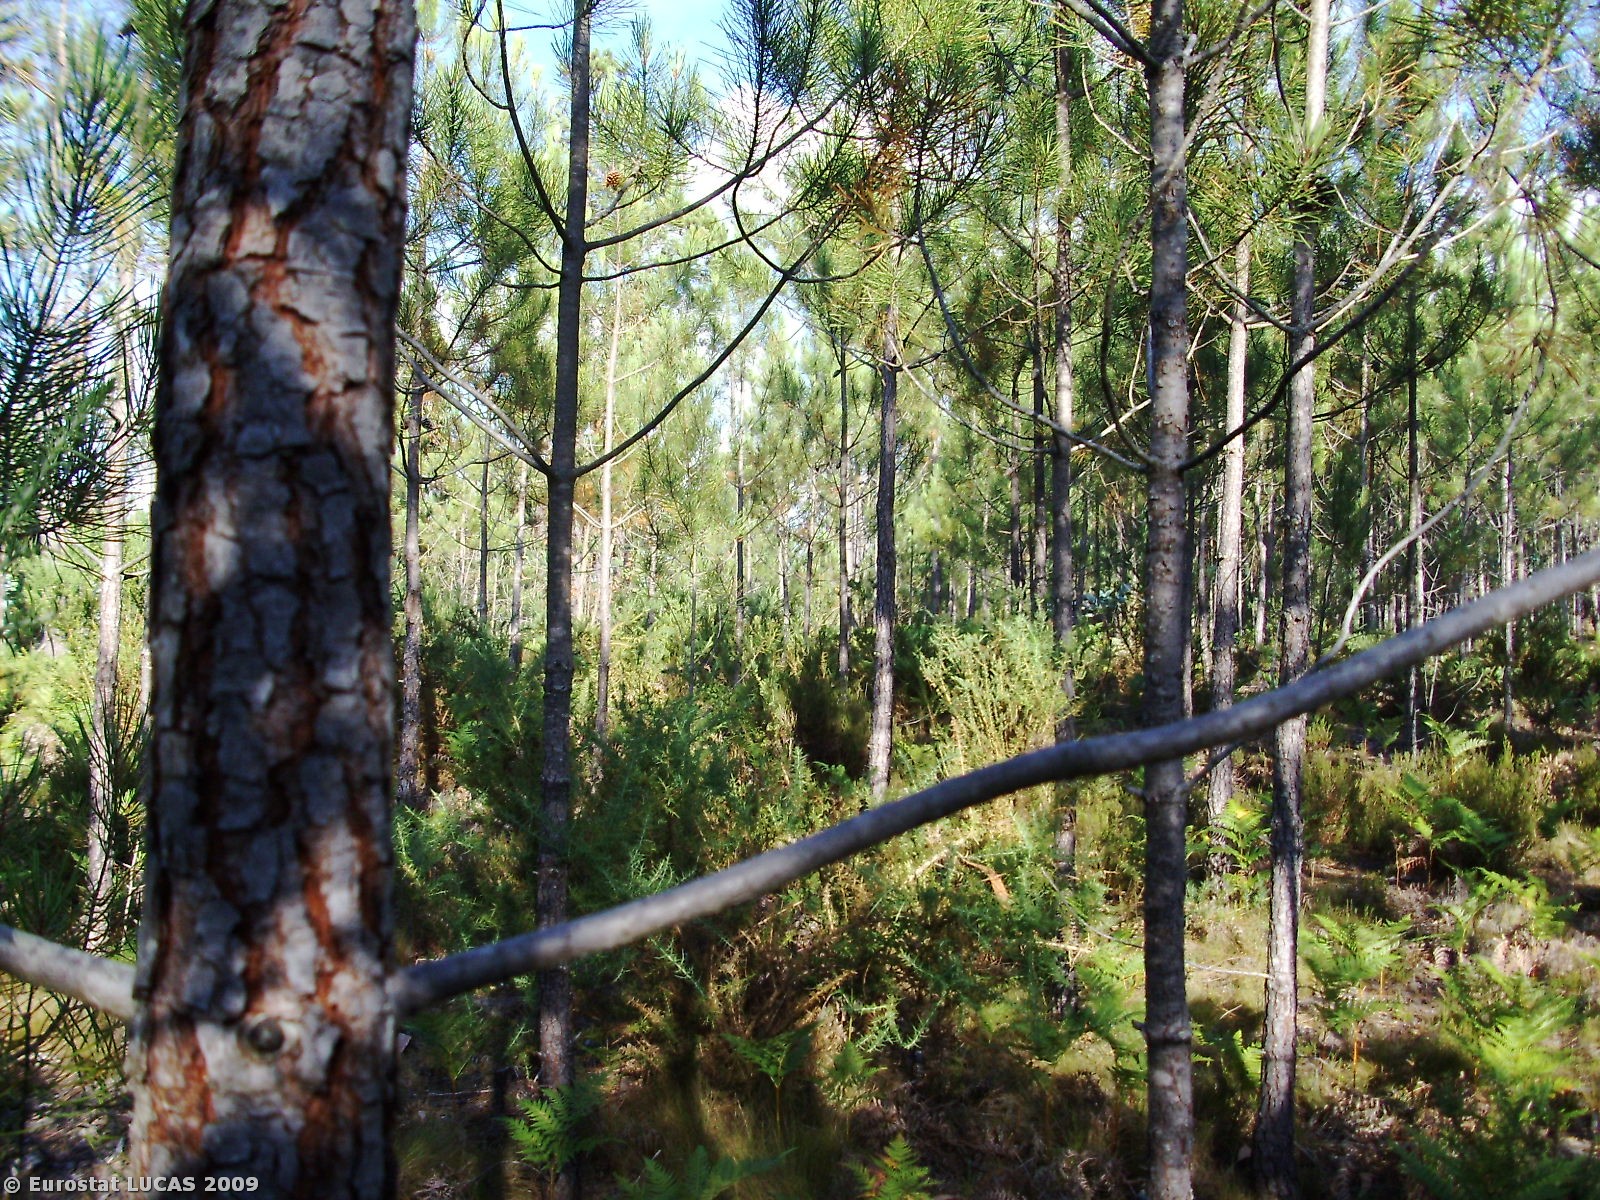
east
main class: Woodland
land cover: Coniferous woodland
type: coniferous forest of the mediterranean region
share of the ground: 50 - 75 %
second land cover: Shrubland with sparse tree cover
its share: 10 - 25 %
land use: Forestry
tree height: > 5 m
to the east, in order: Coniferous woodland; Shrubland with sparse tree cover; Coniferous woodland; Tracks; Shrubland with sparse tree cover; Coniferous woodland; Tracks; Broadleaved woodland; Coniferous woodland; Tracks; Coniferous woodland; Tracks; Coniferous woodland
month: July
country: PT
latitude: 39.4522
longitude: -9.1606
